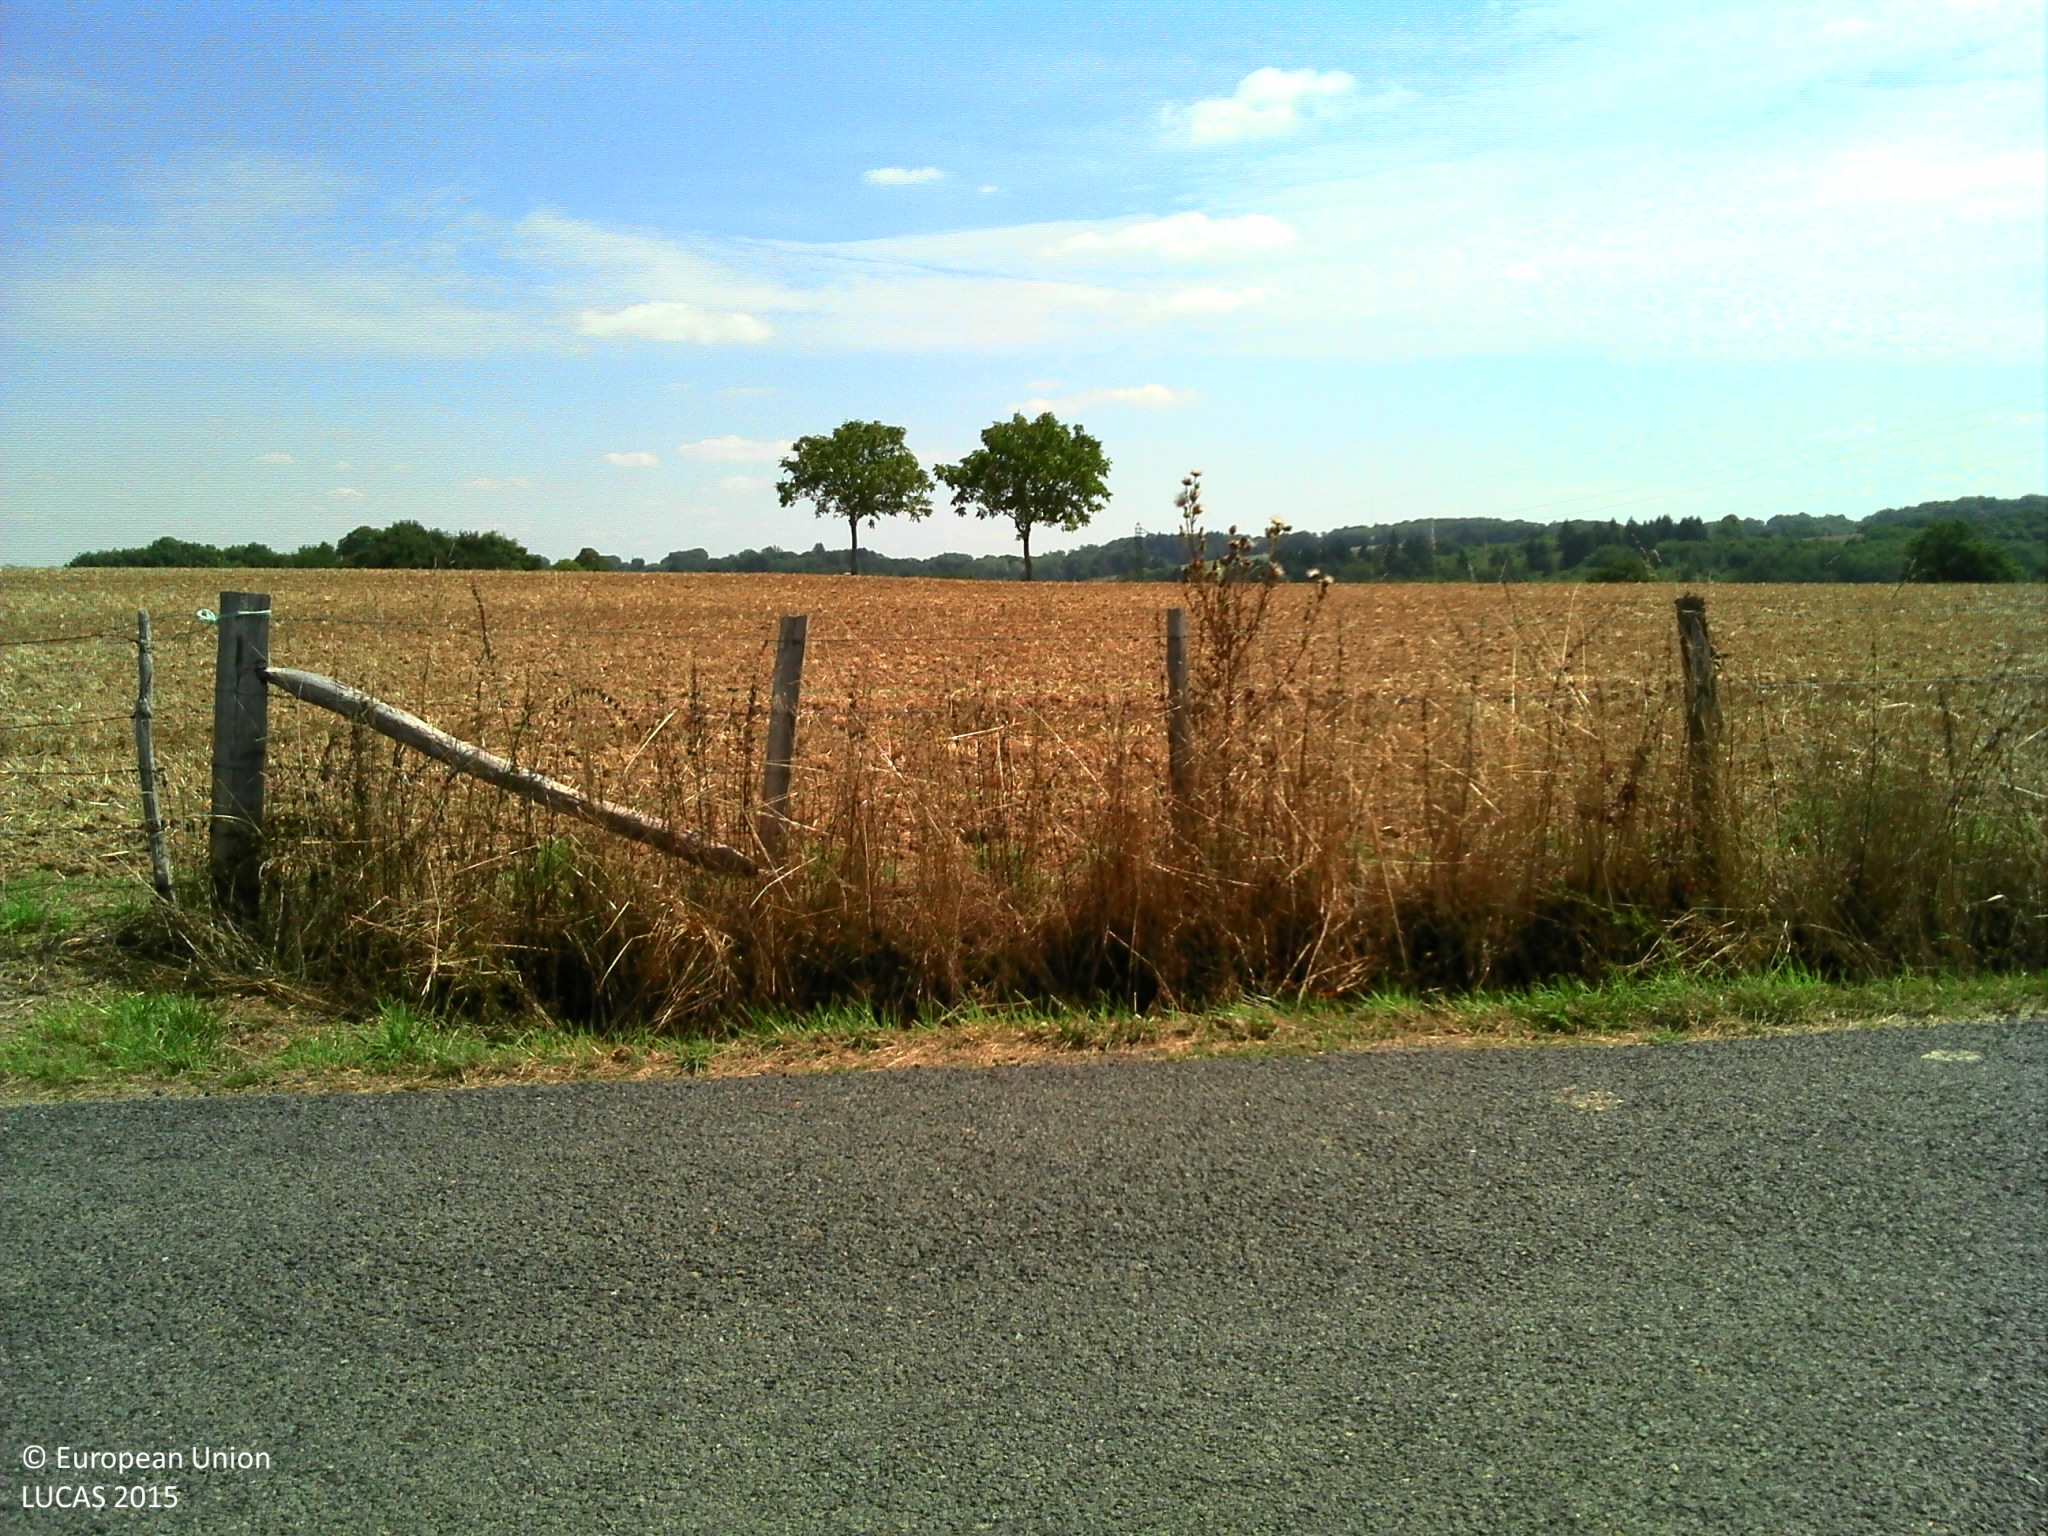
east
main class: Cropland
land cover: Maize
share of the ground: > 75 %
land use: Agriculture (excluding fallow land and kitchen gardens)
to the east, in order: Maize; Abandoned hedges; Grass margins; Paved roads, cycling and walking lanes; Grass margins; Fences; Grassland without tree/shrub cover; Fences; Grassland without tree/shrub cover
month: August
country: FR
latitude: 45.6345
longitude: 1.3072
